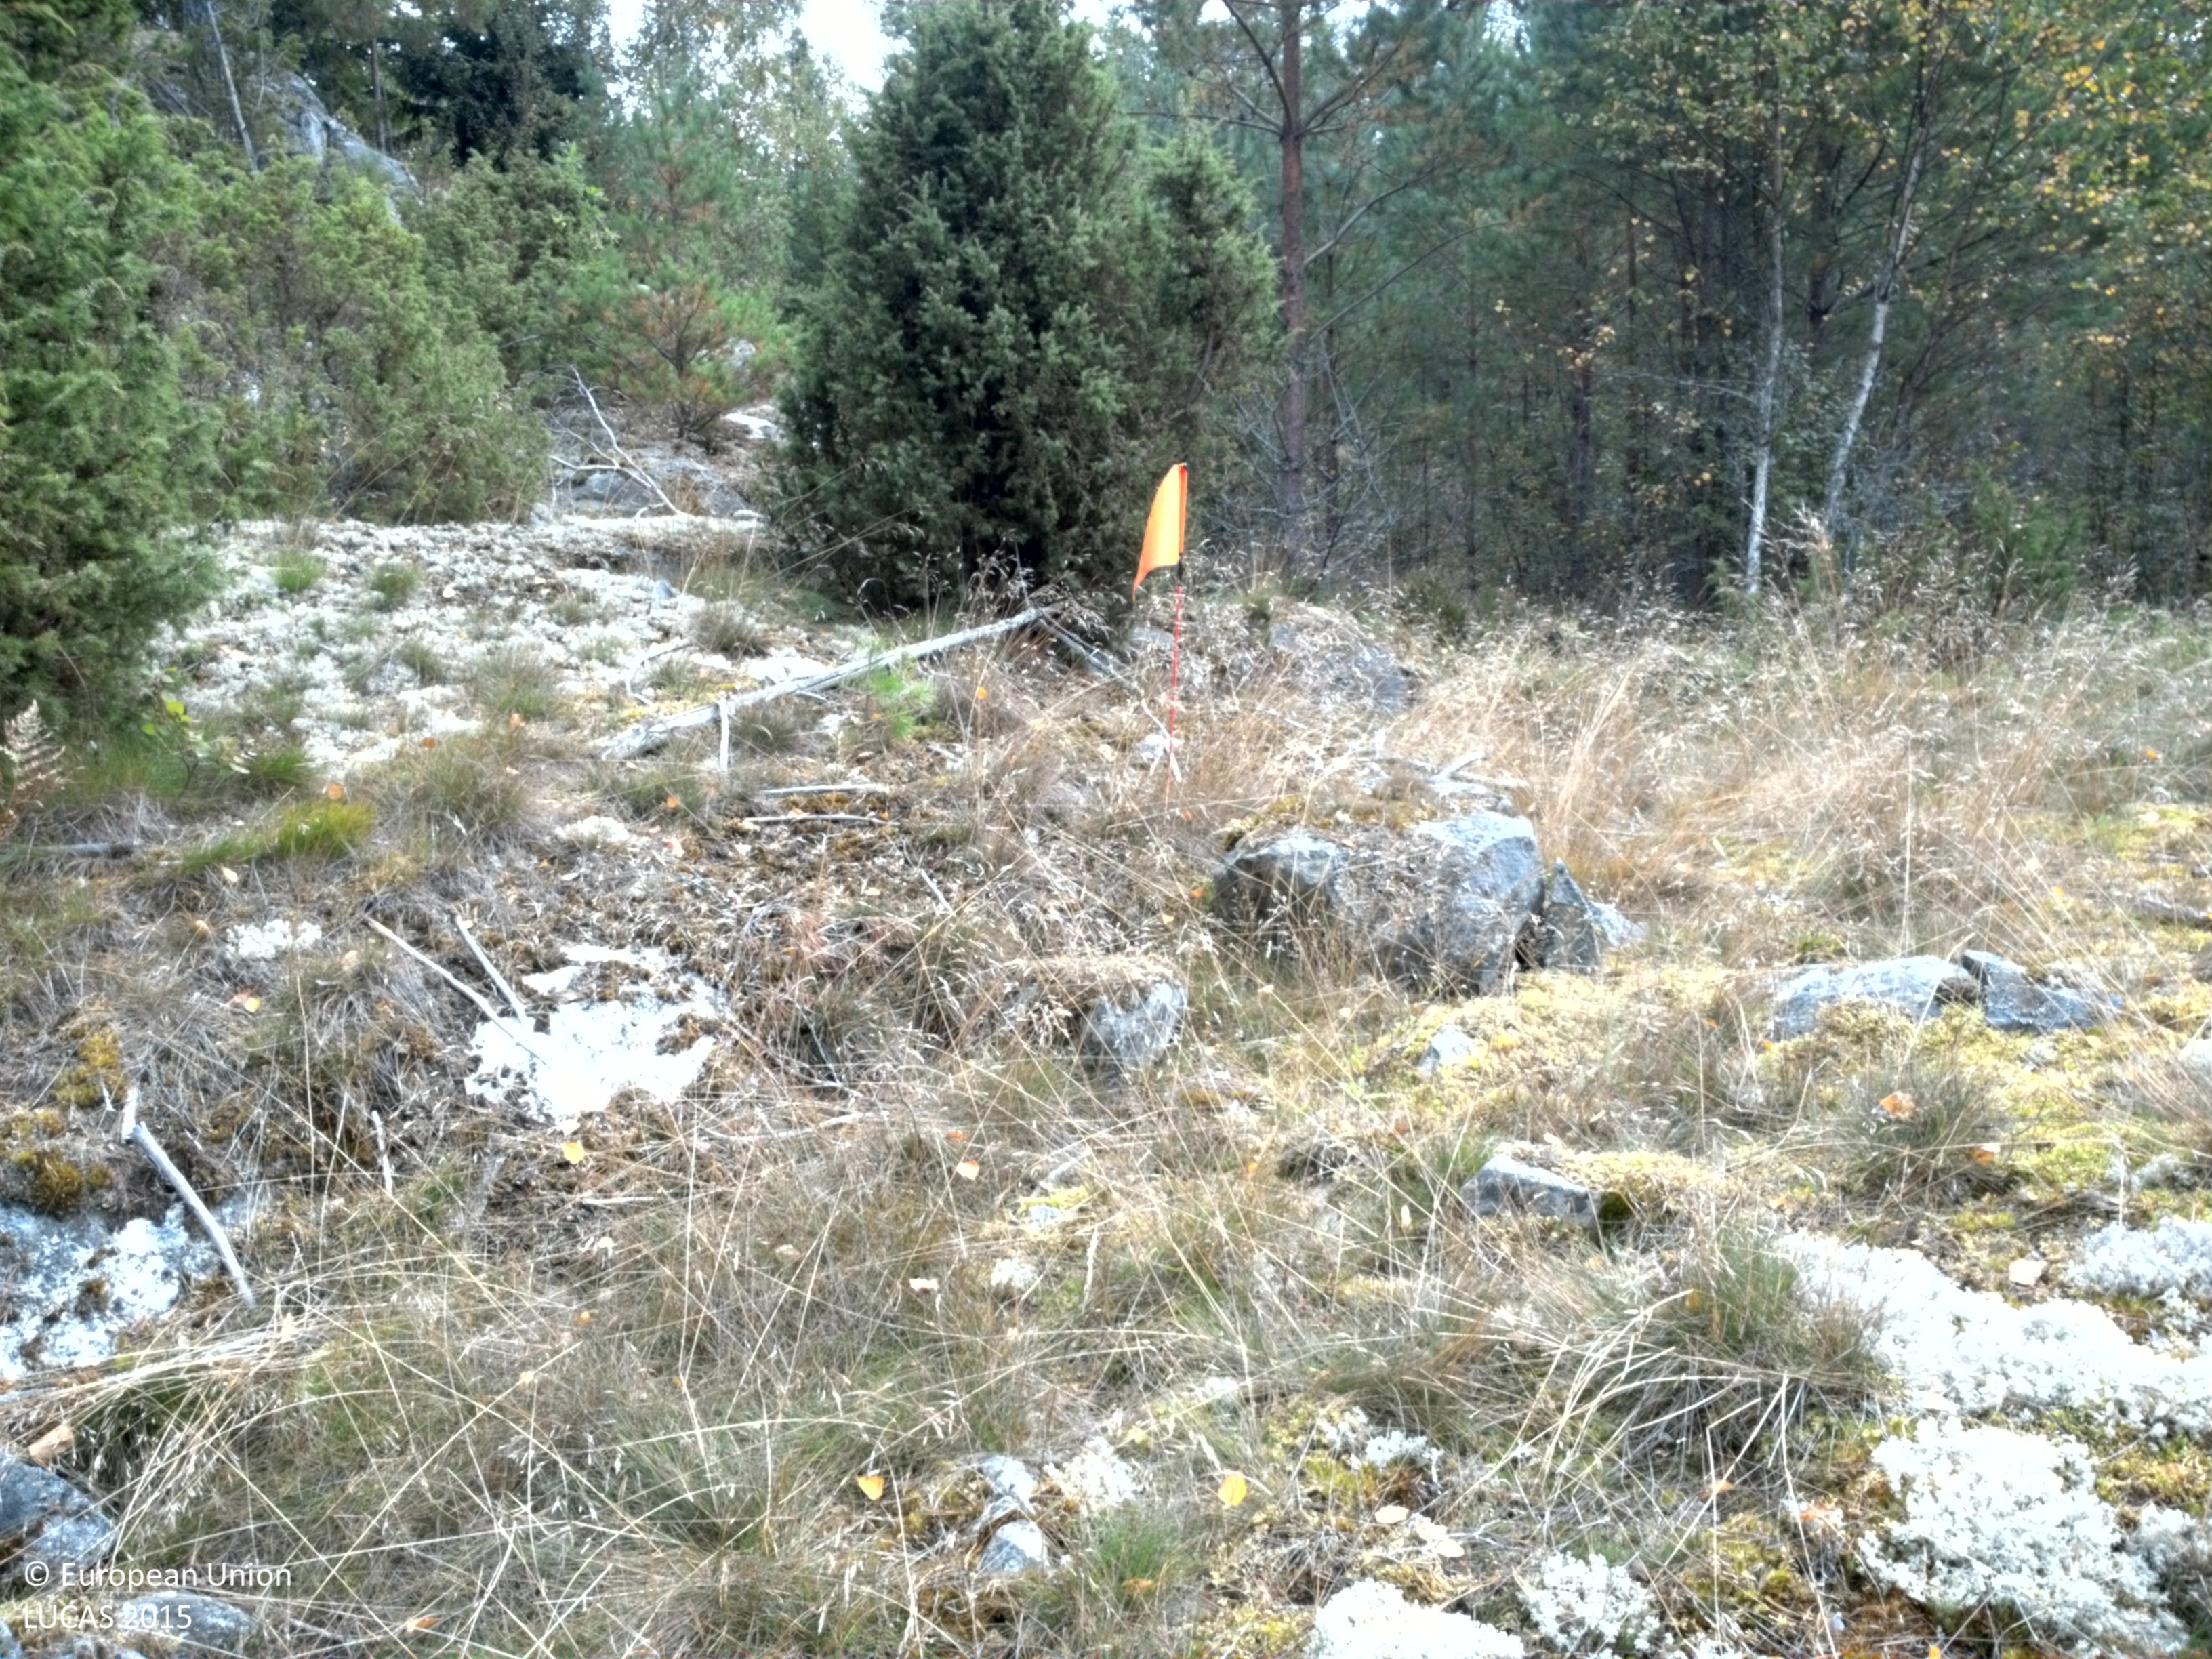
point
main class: Woodland
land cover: Spruce dominated mixed woodland
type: boreal forest
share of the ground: 25 - 50 %
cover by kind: coniferous forest trees 30 %, lichens and mosses 30 %, herbaceous plants 25 %, broadleaved forest trees 10 %, consolidated bare surface 5 %
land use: Forestry
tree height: > 5 m
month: September
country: SE
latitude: 59.2533
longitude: 18.5065
